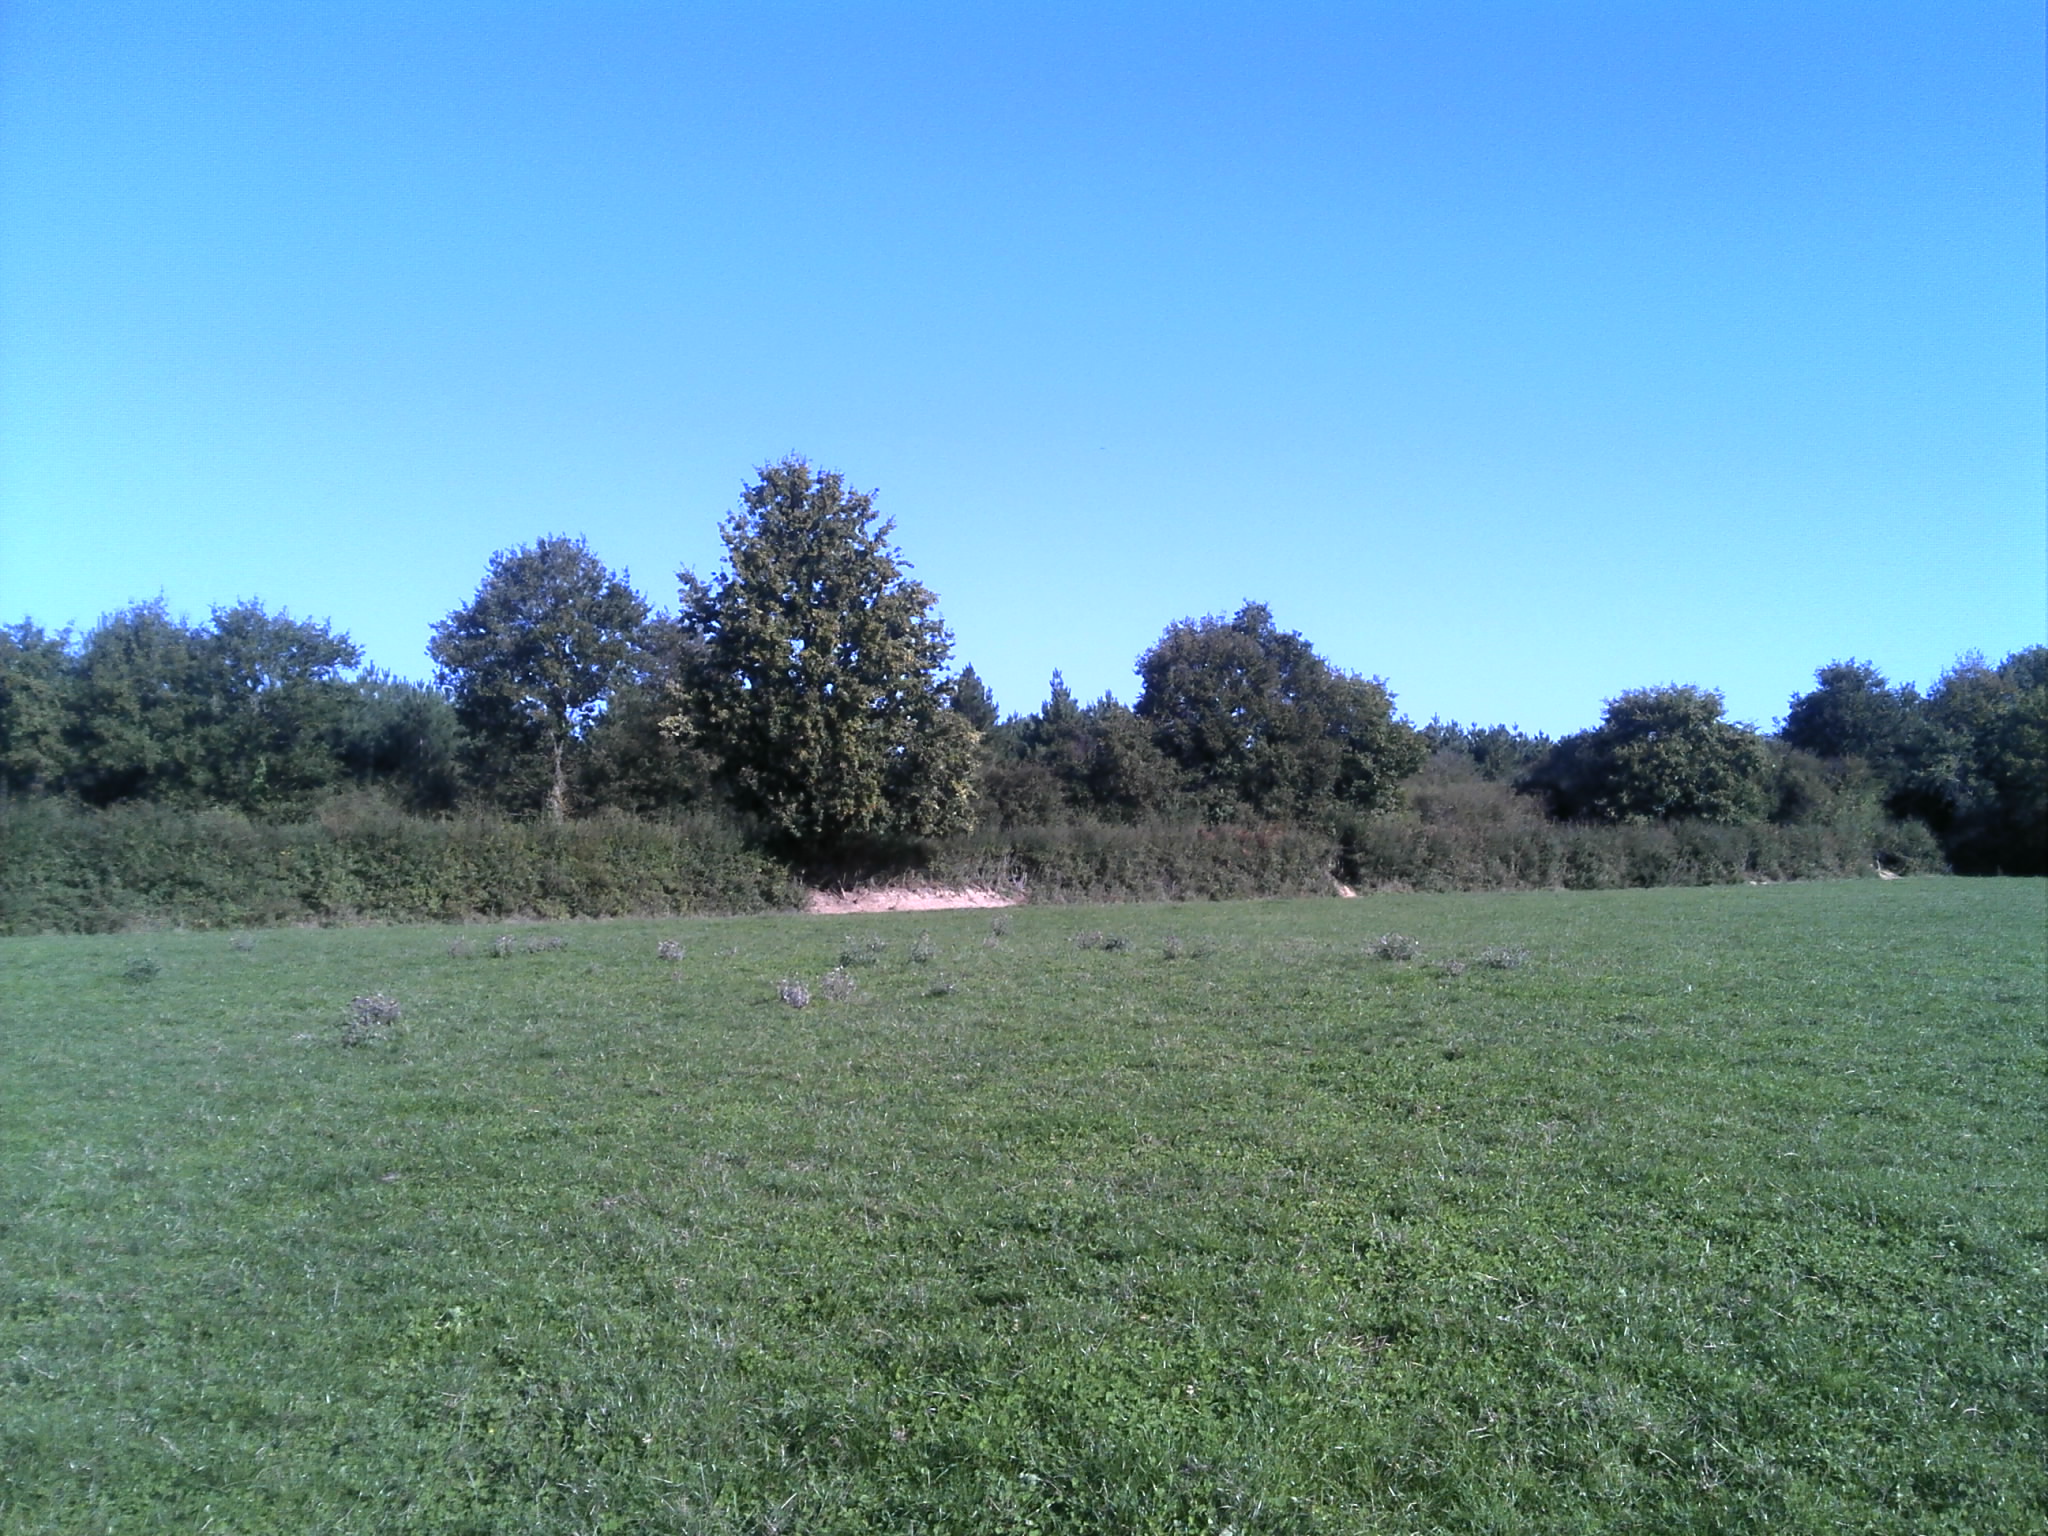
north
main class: Grassland
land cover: Grassland without tree/shrub cover
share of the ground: > 75 %
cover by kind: herbaceous plants 100 %
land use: Agriculture (excluding fallow land and kitchen gardens)
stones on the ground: < 10 %
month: October
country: FR
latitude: 47.6128
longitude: -1.0397
